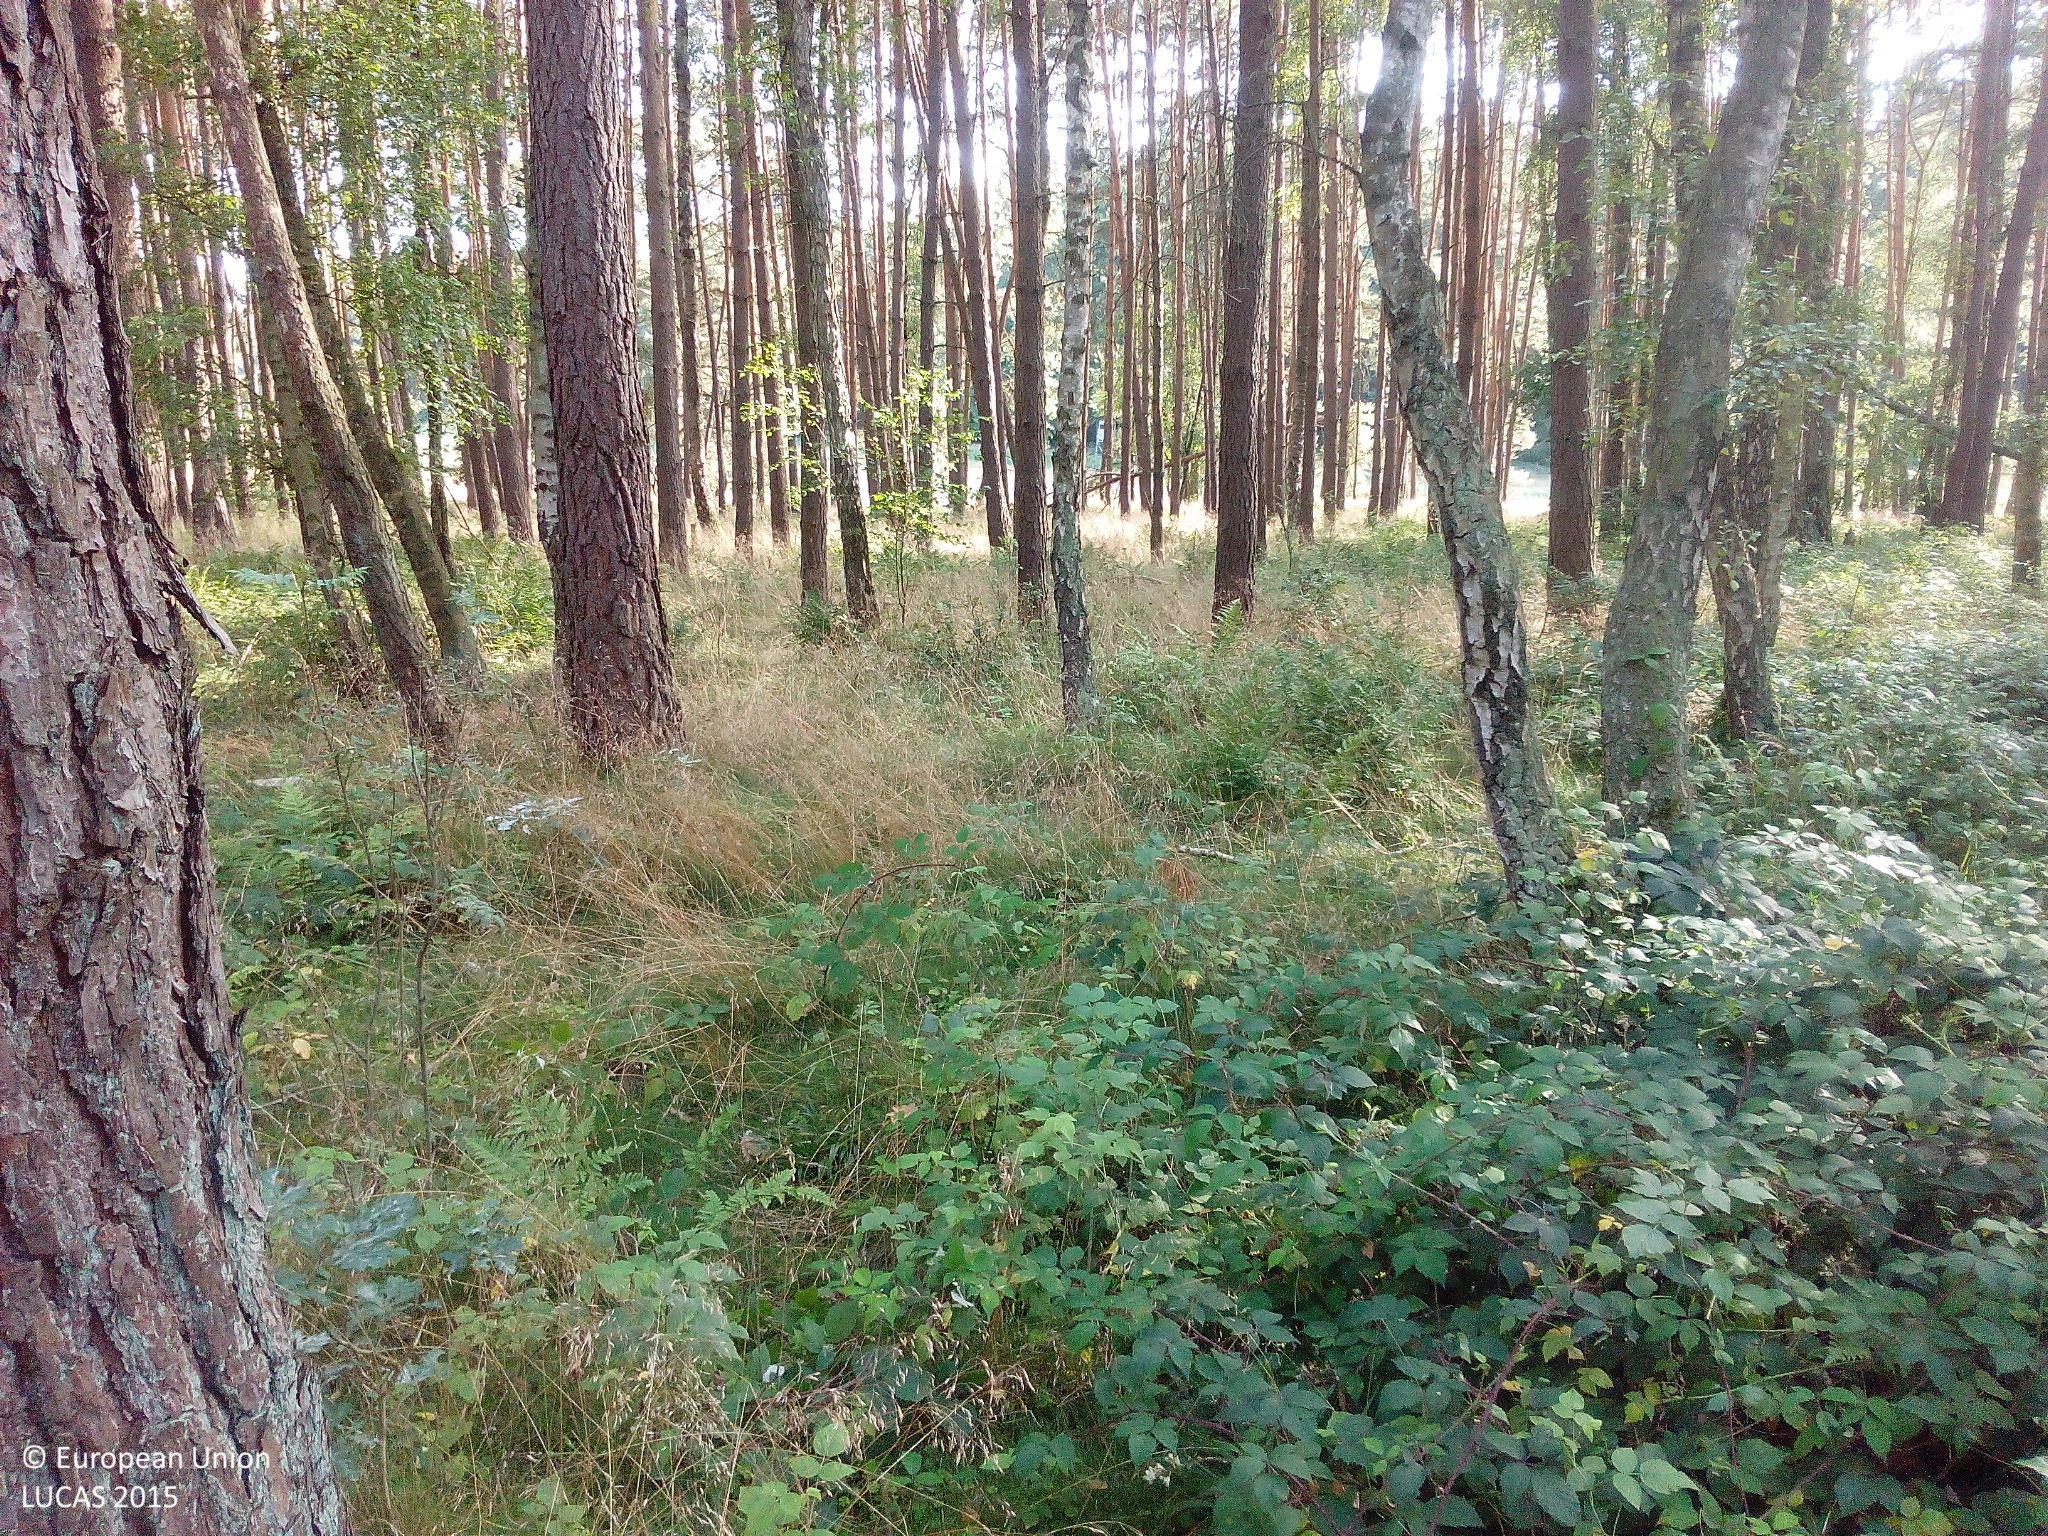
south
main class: Woodland
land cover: Pine dominated coniferous woodland
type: hemiboreal forest and nemoral coniferous forest and mixed broadleaved-coniferous forest
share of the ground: > 75 %
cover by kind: coniferous forest trees 80 %, shrubs 10 %, herbaceous plants 10 %
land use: Forestry
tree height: > 5 m
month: August
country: DE
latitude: 53.5388
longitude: 12.4588
